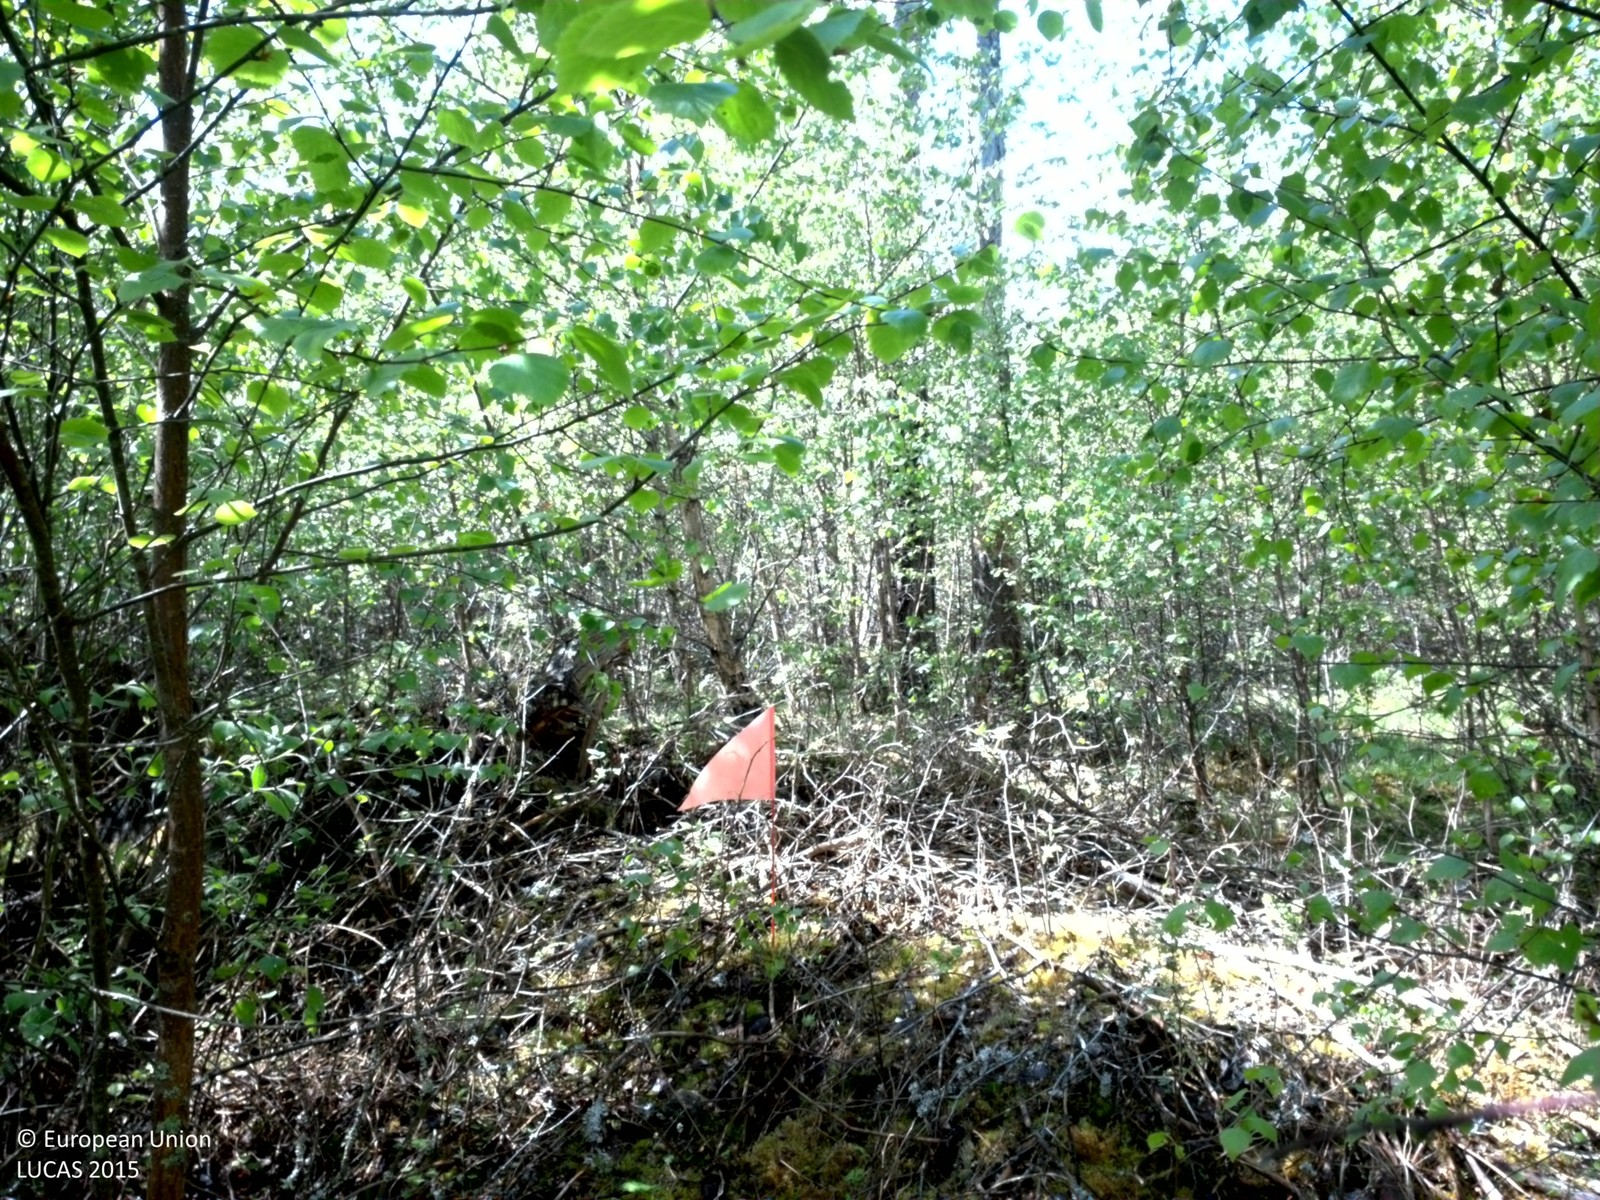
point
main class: Woodland
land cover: Broadleaved woodland
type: boreal forest
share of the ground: > 75 %
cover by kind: broadleaved forest trees 75 %, herbaceous plants 10 %, lichens and mosses 10 %, shrubs 5 %
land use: Forestry
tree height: < 5 m
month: June
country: SE
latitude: 56.7708
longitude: 14.6276
